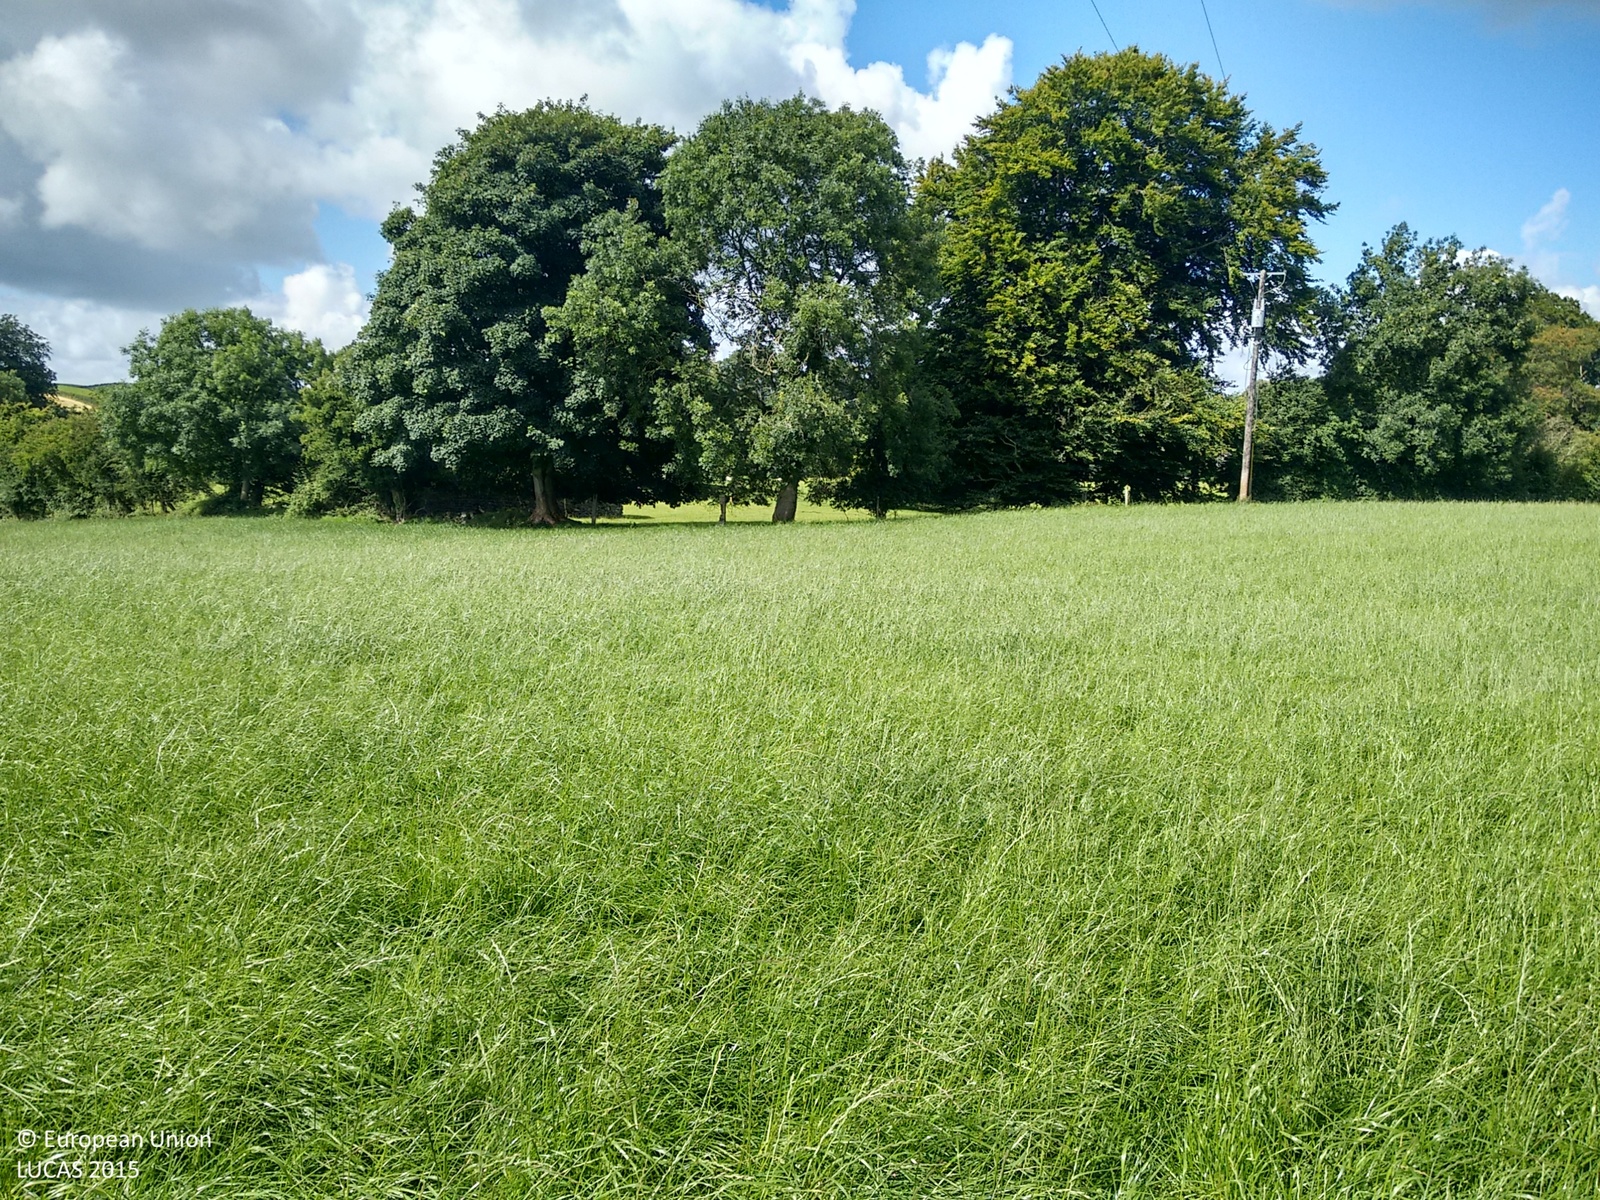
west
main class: Cropland
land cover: Temporary grasslands
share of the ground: > 75 %
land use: Agriculture (excluding fallow land and kitchen gardens)
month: August
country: IE
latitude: 54.0400
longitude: -6.5109
